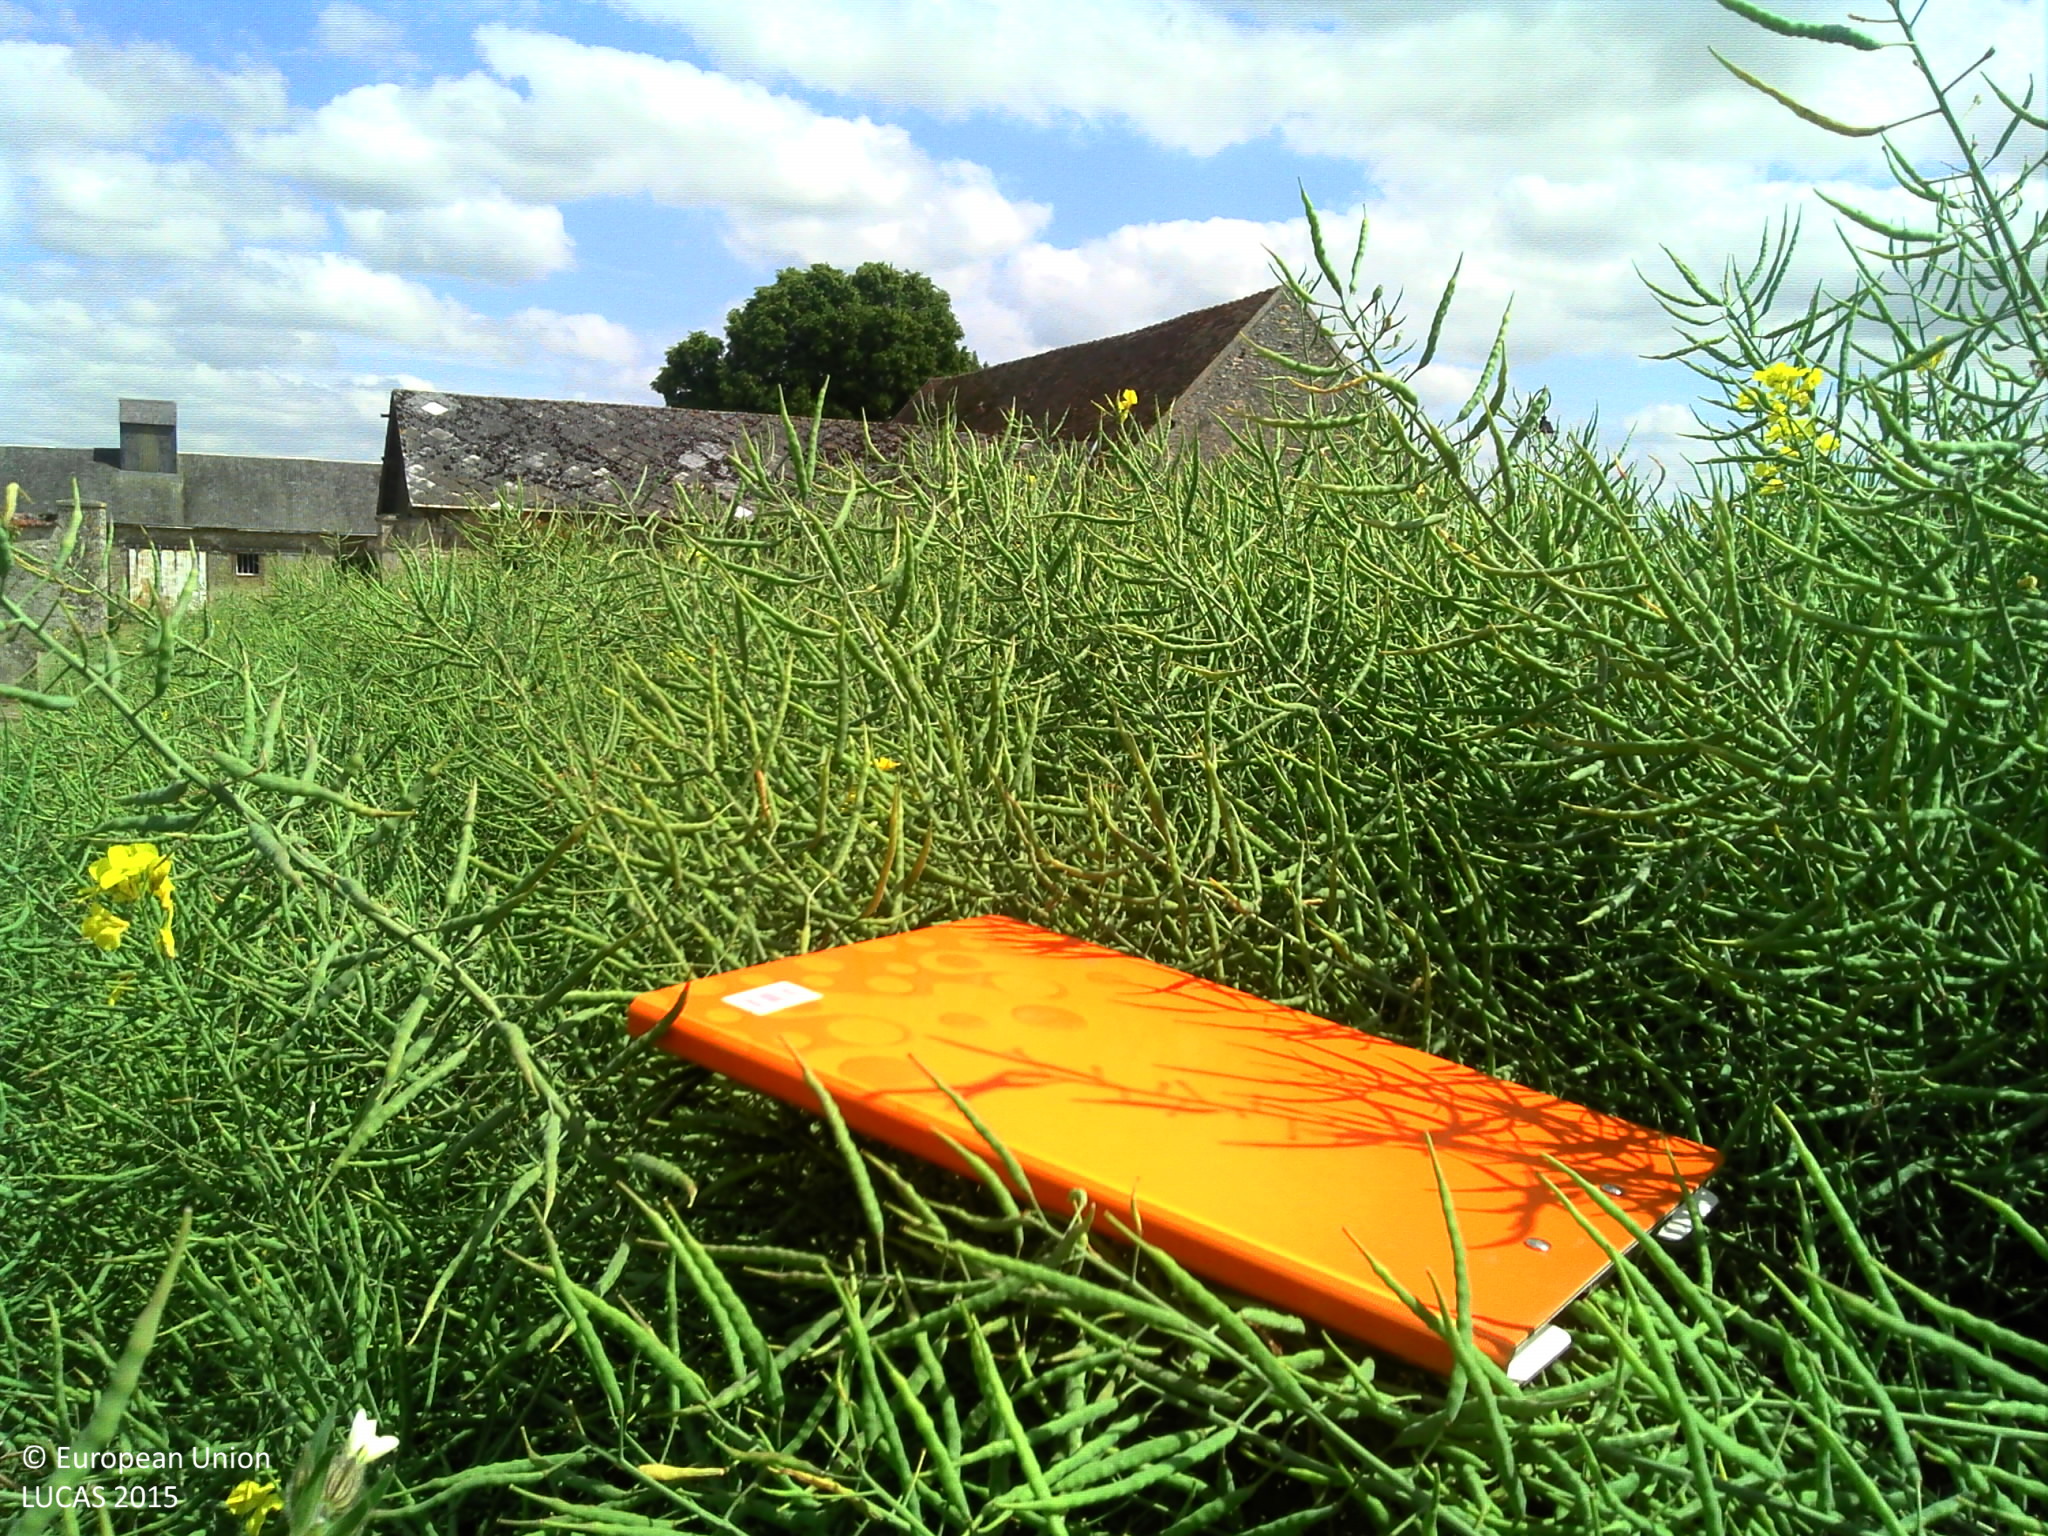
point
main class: Cropland
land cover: Rape and turnip rape
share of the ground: > 75 %
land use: Agriculture (excluding fallow land and kitchen gardens)
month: June
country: FR
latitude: 48.4308
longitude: 1.8903
